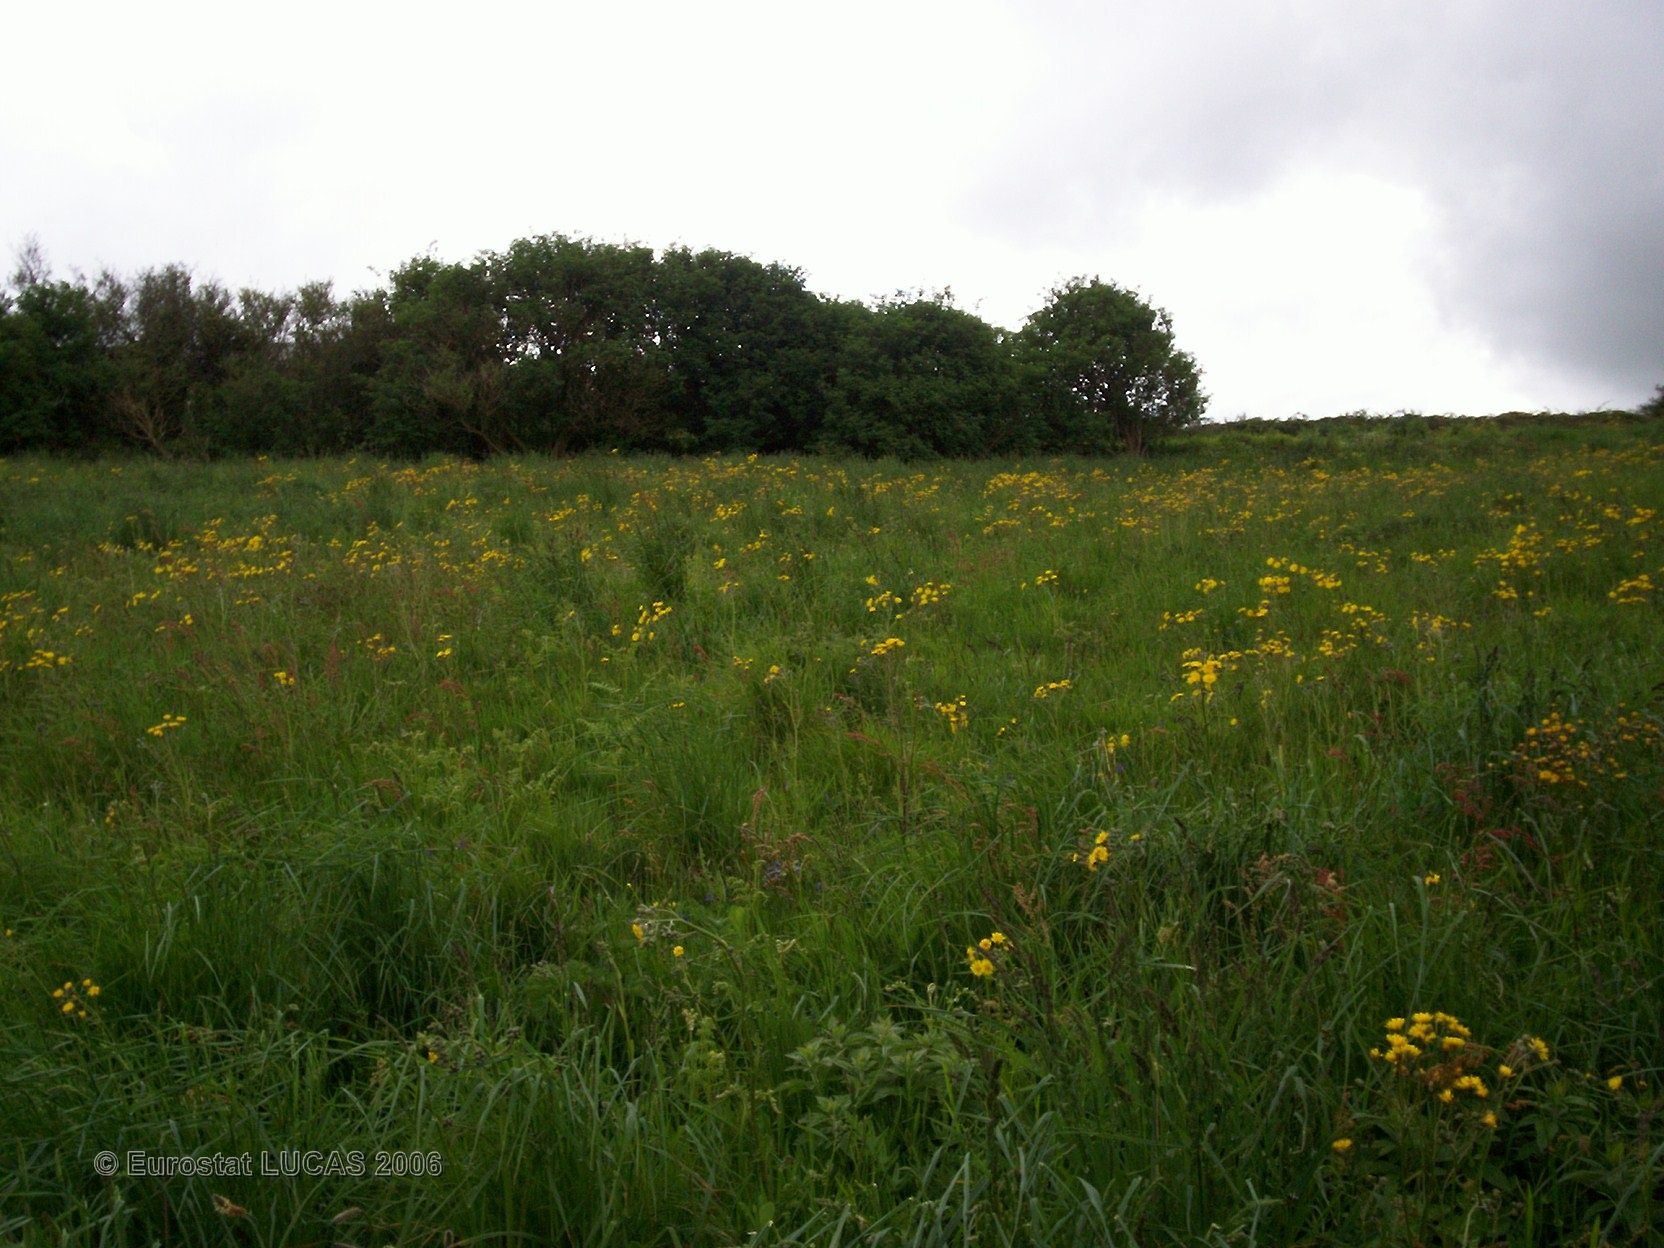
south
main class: Grassland
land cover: Grassland without tree/shrub cover
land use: Agriculture (excluding fallow land and kitchen gardens)
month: May
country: FR
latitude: 48.6941
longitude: -3.7101
